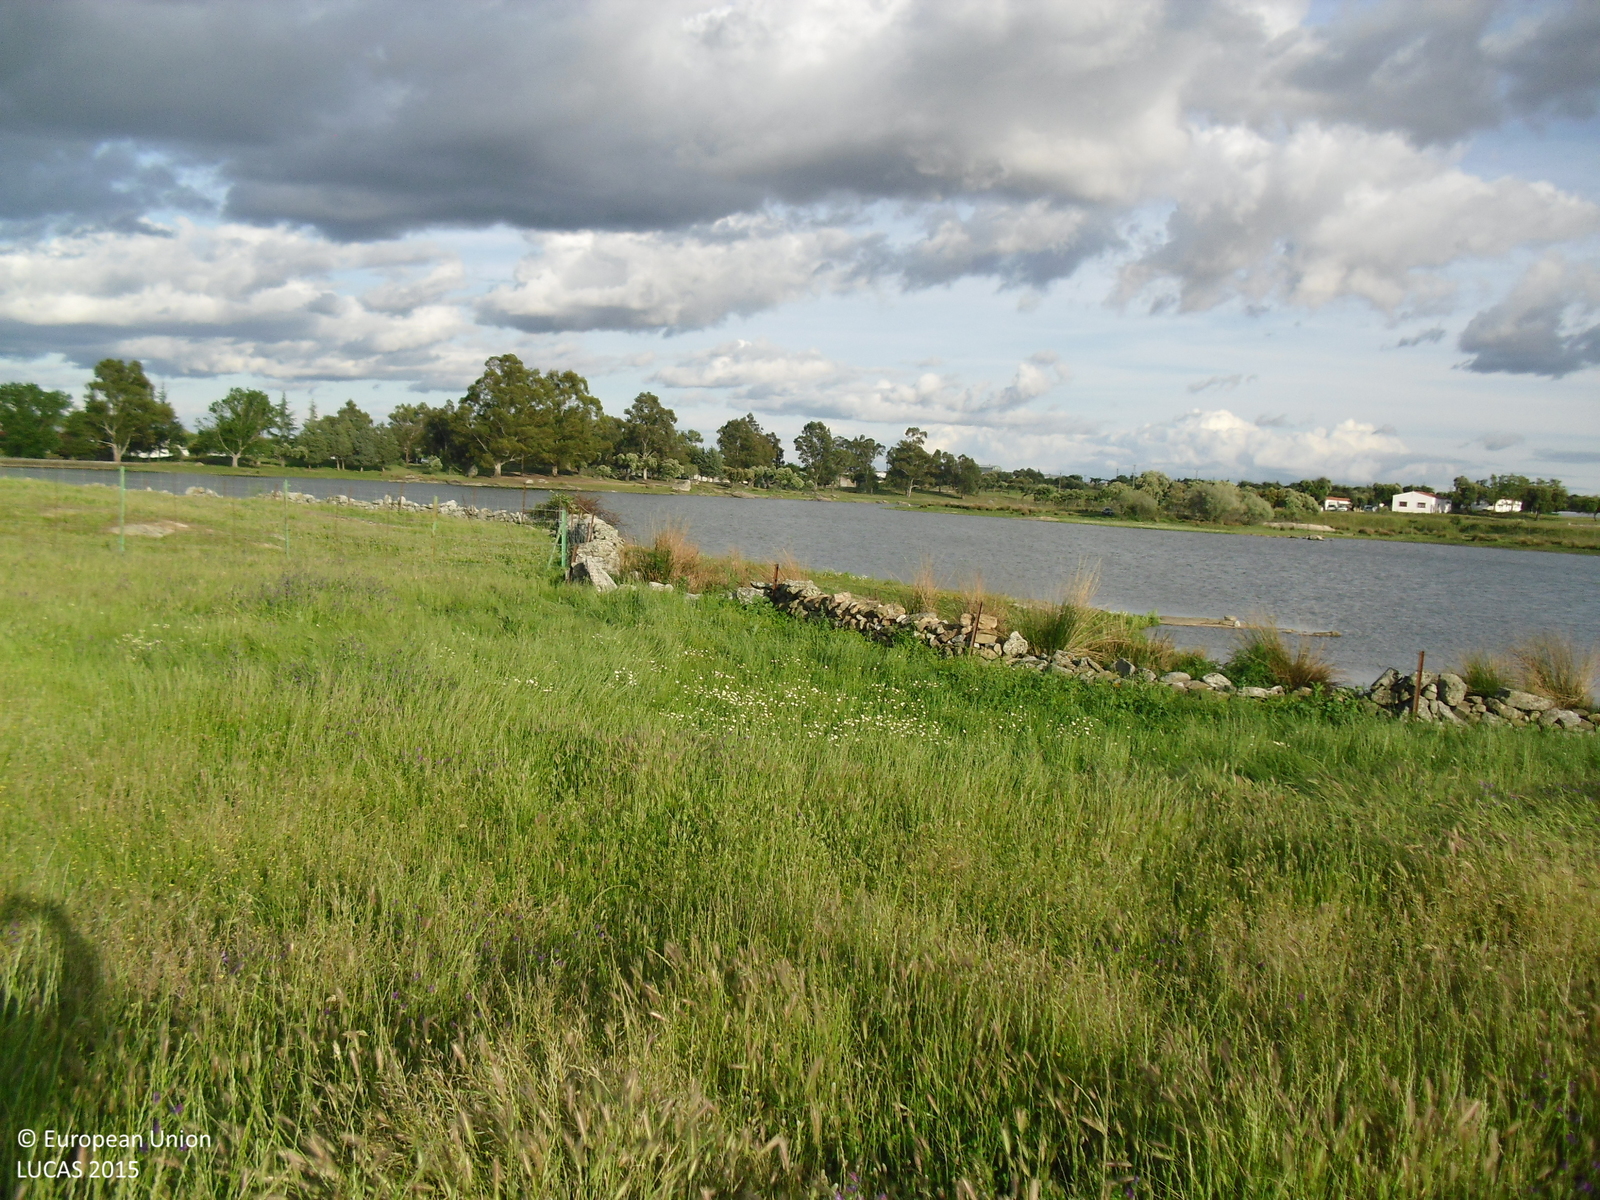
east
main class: Grassland
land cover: Grassland without tree/shrub cover
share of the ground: > 75 %
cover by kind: herbaceous plants 100 %
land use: Agriculture (excluding fallow land and kitchen gardens)
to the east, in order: Grassland without tree/shrub cover; Fences; Grassland without tree/shrub cover; Dry stone walls; Shruby margins; Grassland without tree/shrub cover; Inland fresh water bodies
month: April
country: ES
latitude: 39.5506
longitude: -6.4445
